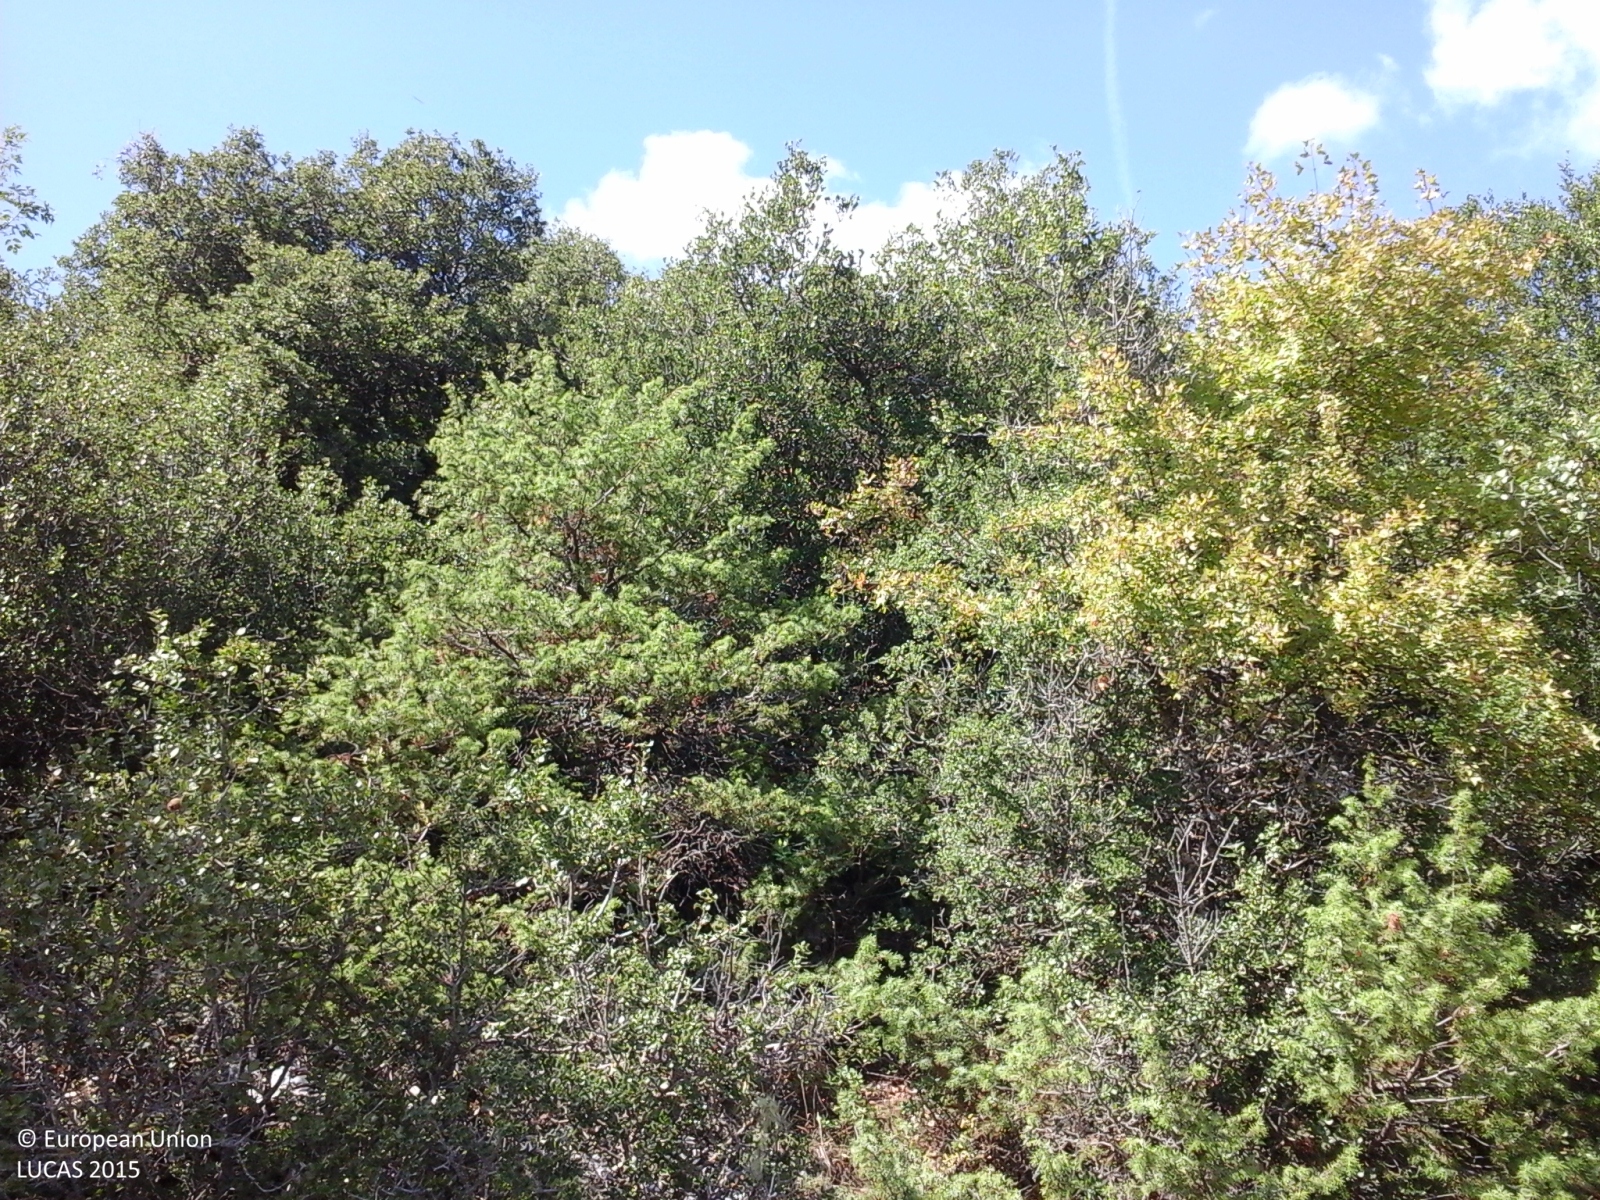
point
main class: Shrubland
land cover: Shrubland with sparse tree cover
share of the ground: > 75 %
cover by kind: shrubs 90 %, broadleaved forest trees 5 %, herbaceous plants 5 %
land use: Semi-natural and natural areas not in use
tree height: < 5 m
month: September
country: GR
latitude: 39.8808
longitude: 20.7023
